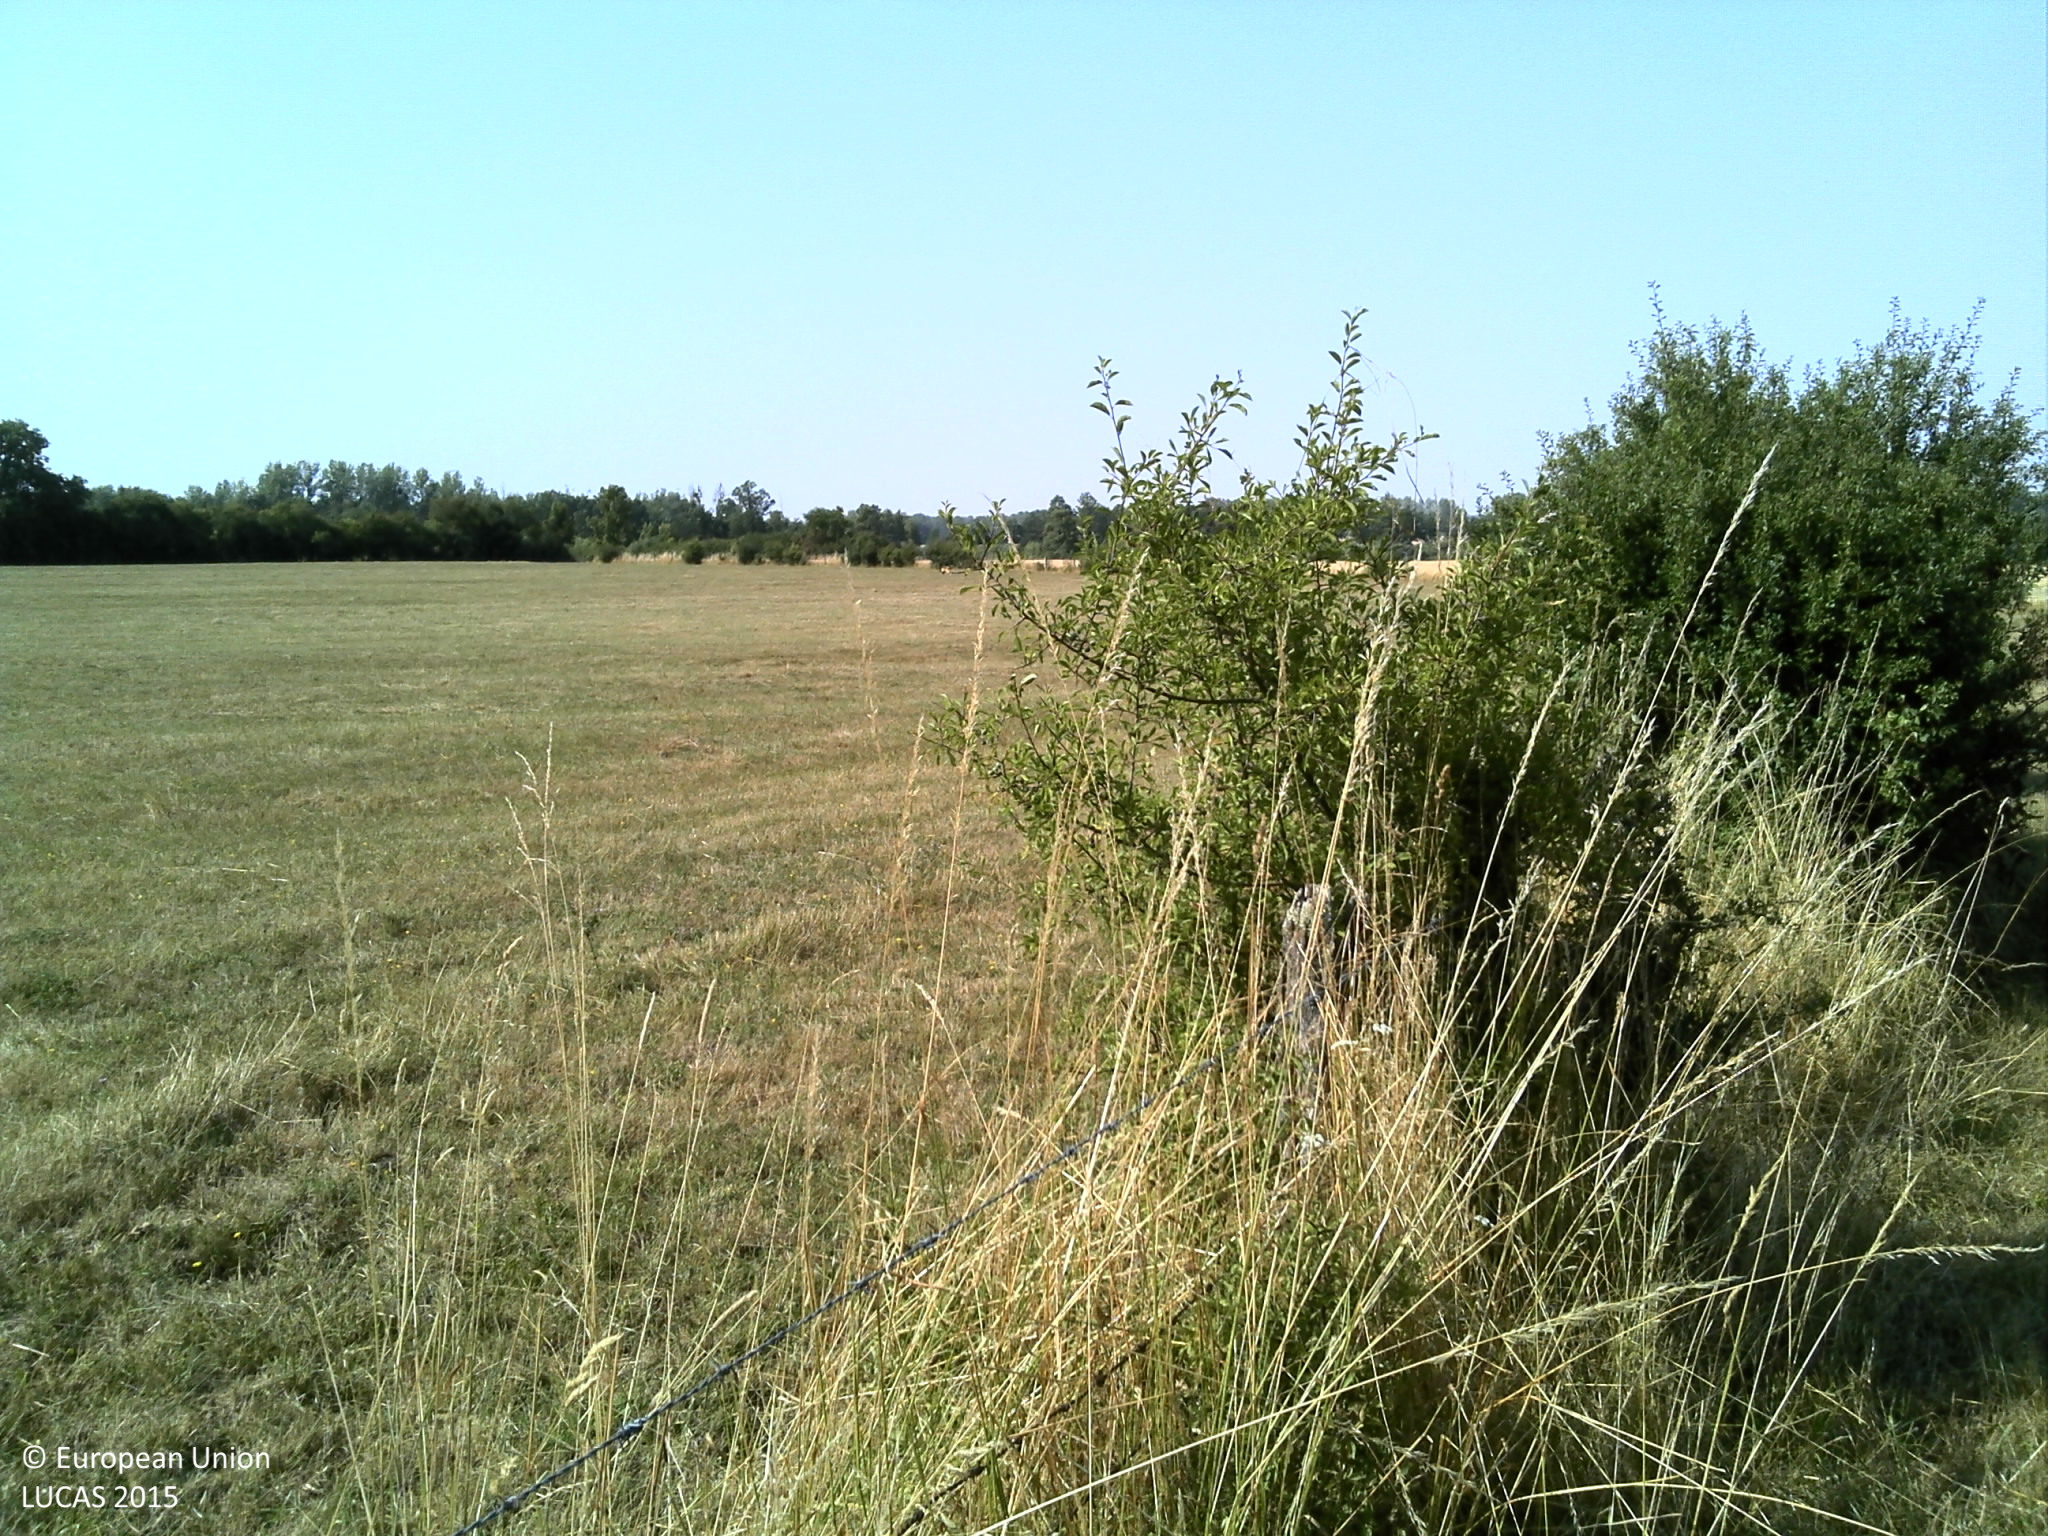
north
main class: Grassland
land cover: Grassland without tree/shrub cover
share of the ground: > 75 %
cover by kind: herbaceous plants 100 %
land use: Agriculture (excluding fallow land and kitchen gardens)
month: July
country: FR
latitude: 48.8583
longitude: 4.8045
